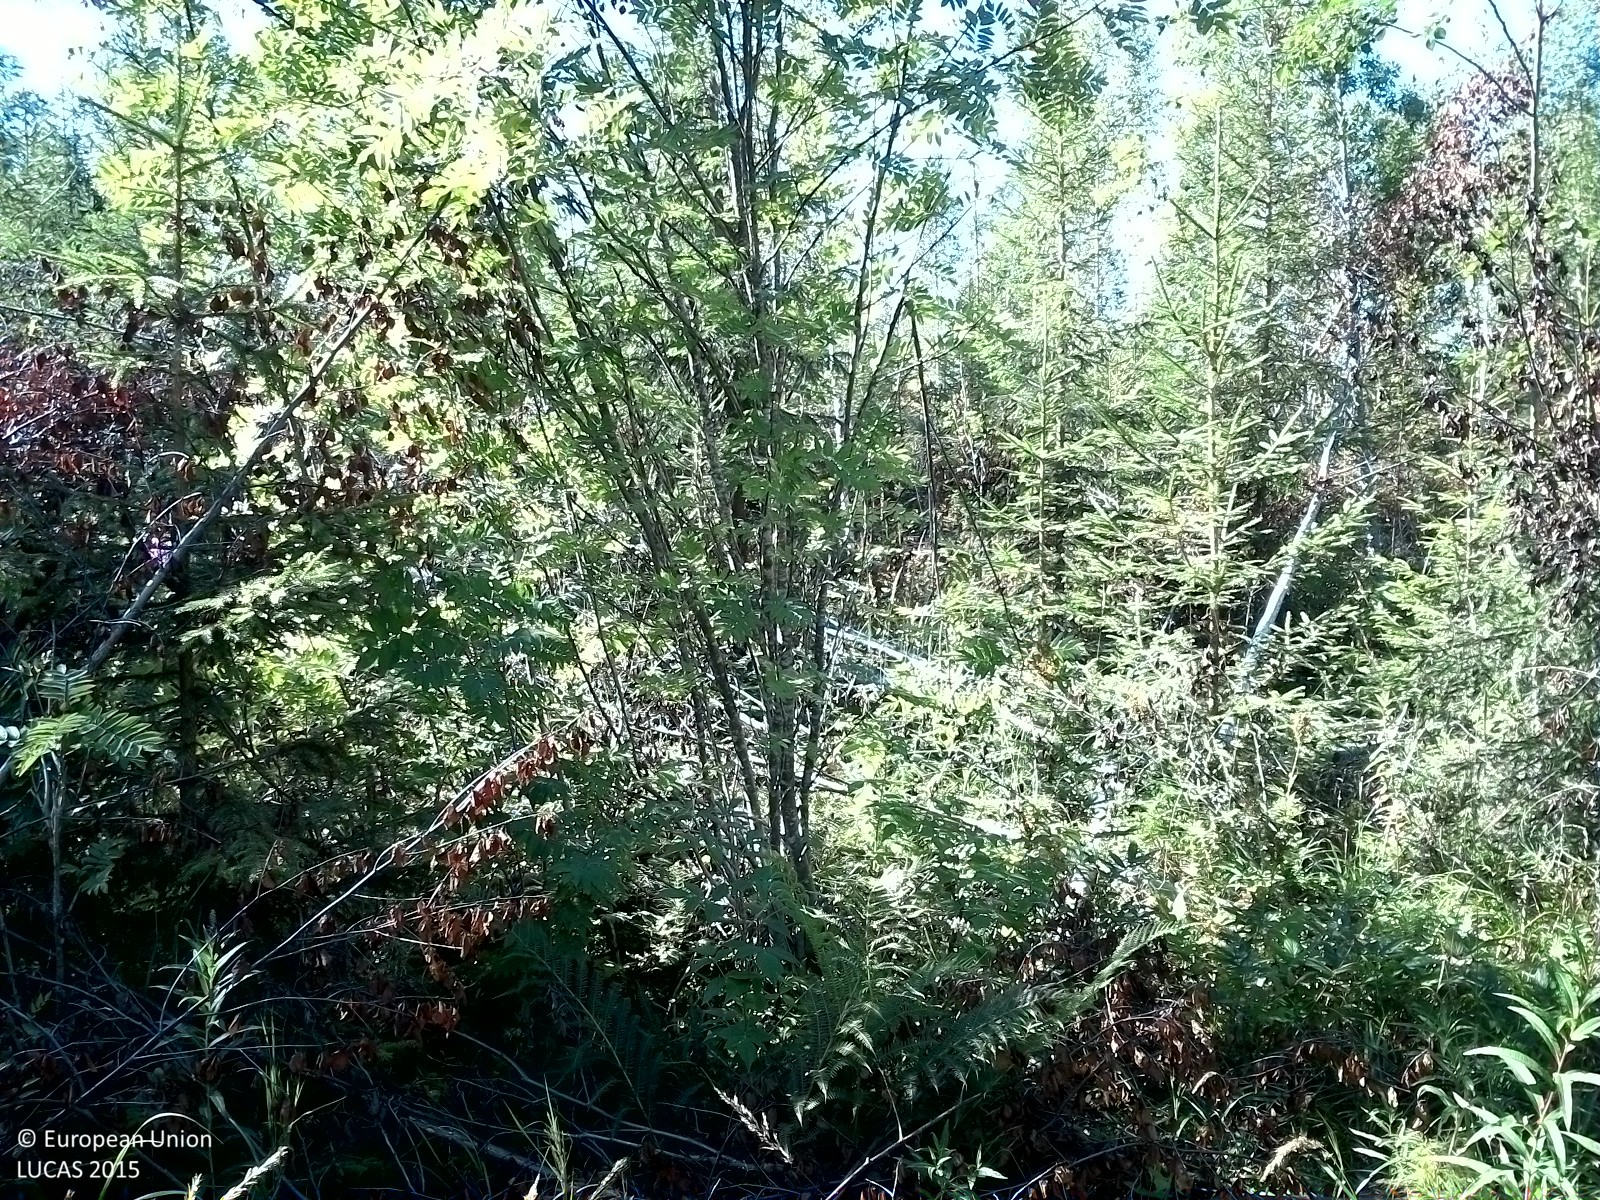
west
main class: Woodland
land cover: Spruce dominated mixed woodland
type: boreal forest
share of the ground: 50 - 75 %
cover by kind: coniferous forest trees 40 %, herbaceous plants 25 %, broadleaved forest trees 20 %, shrubs 15 %
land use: Forestry
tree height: < 5 m
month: August
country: SE
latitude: 62.4192
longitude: 16.4653
